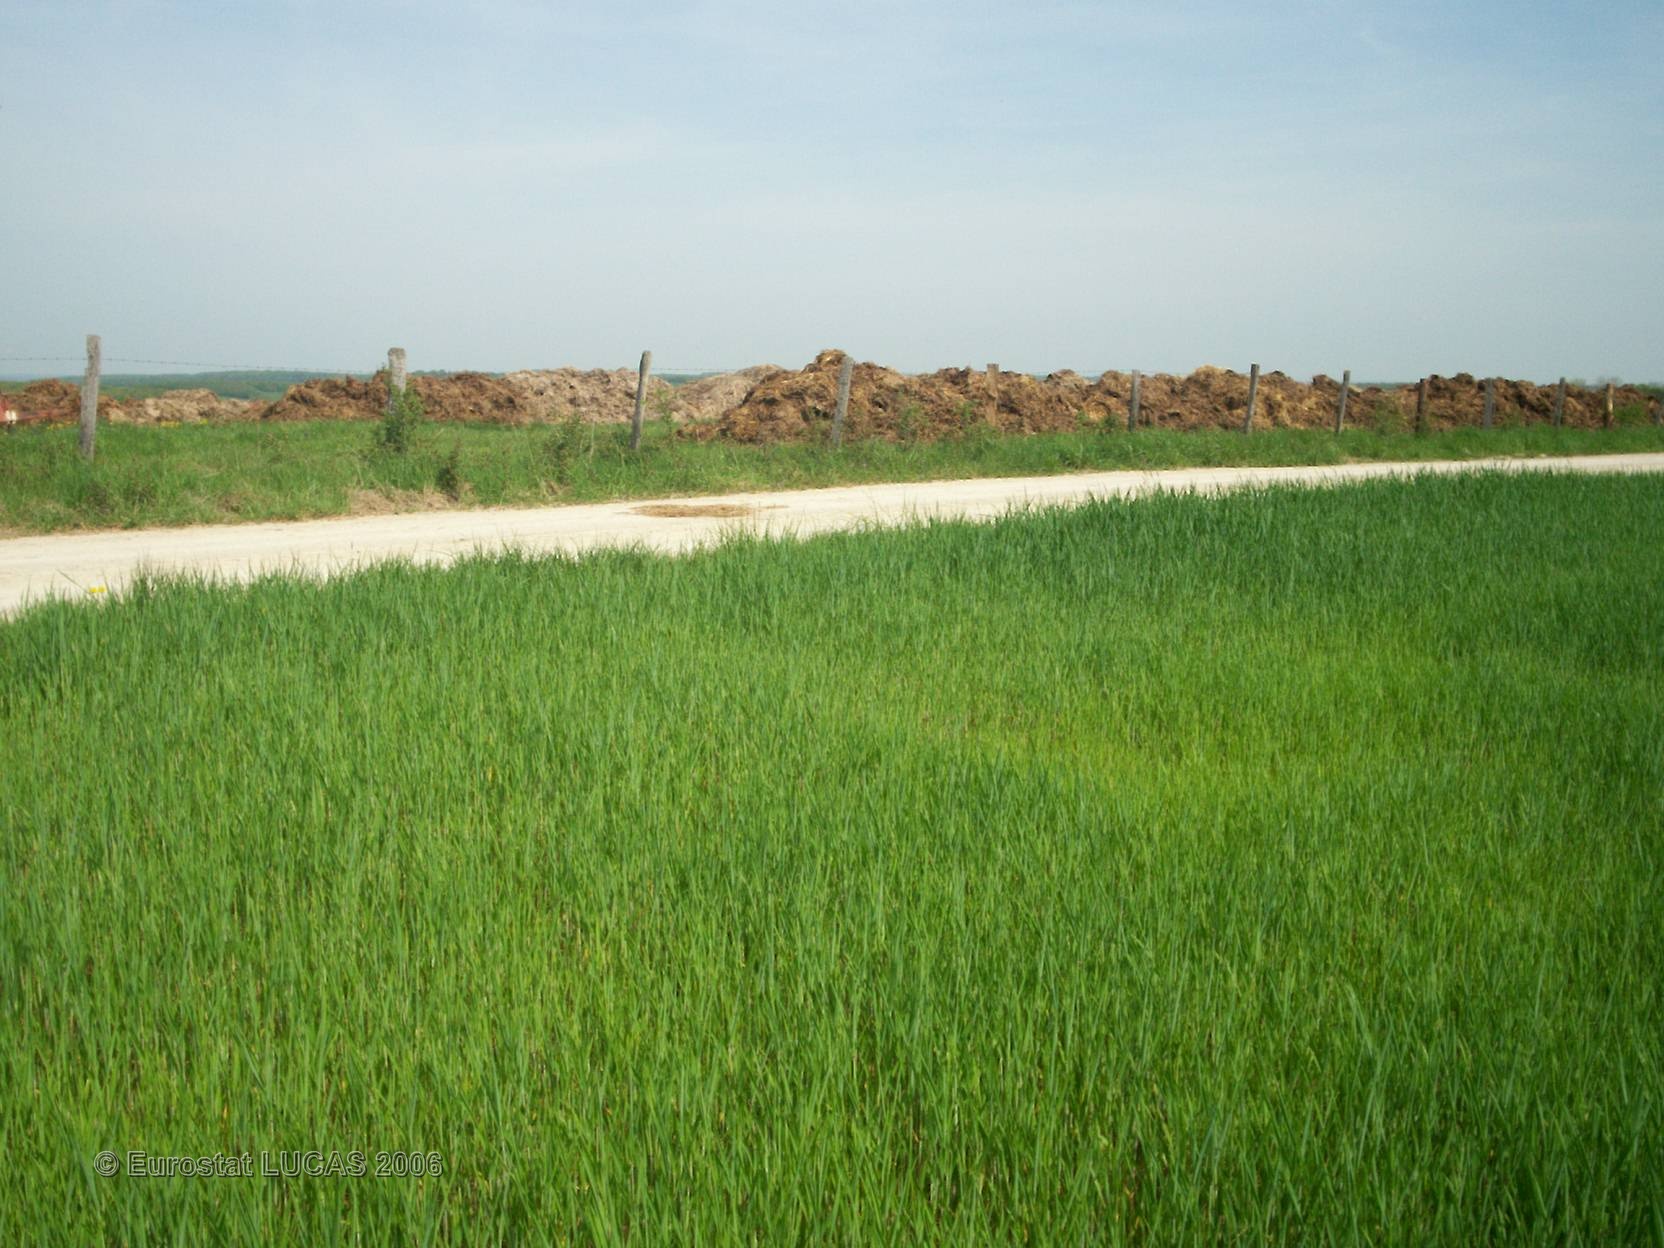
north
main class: Cropland
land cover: Barley
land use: Agriculture (excluding fallow land and kitchen gardens)
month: May
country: FR
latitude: 48.9205
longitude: 6.9845
